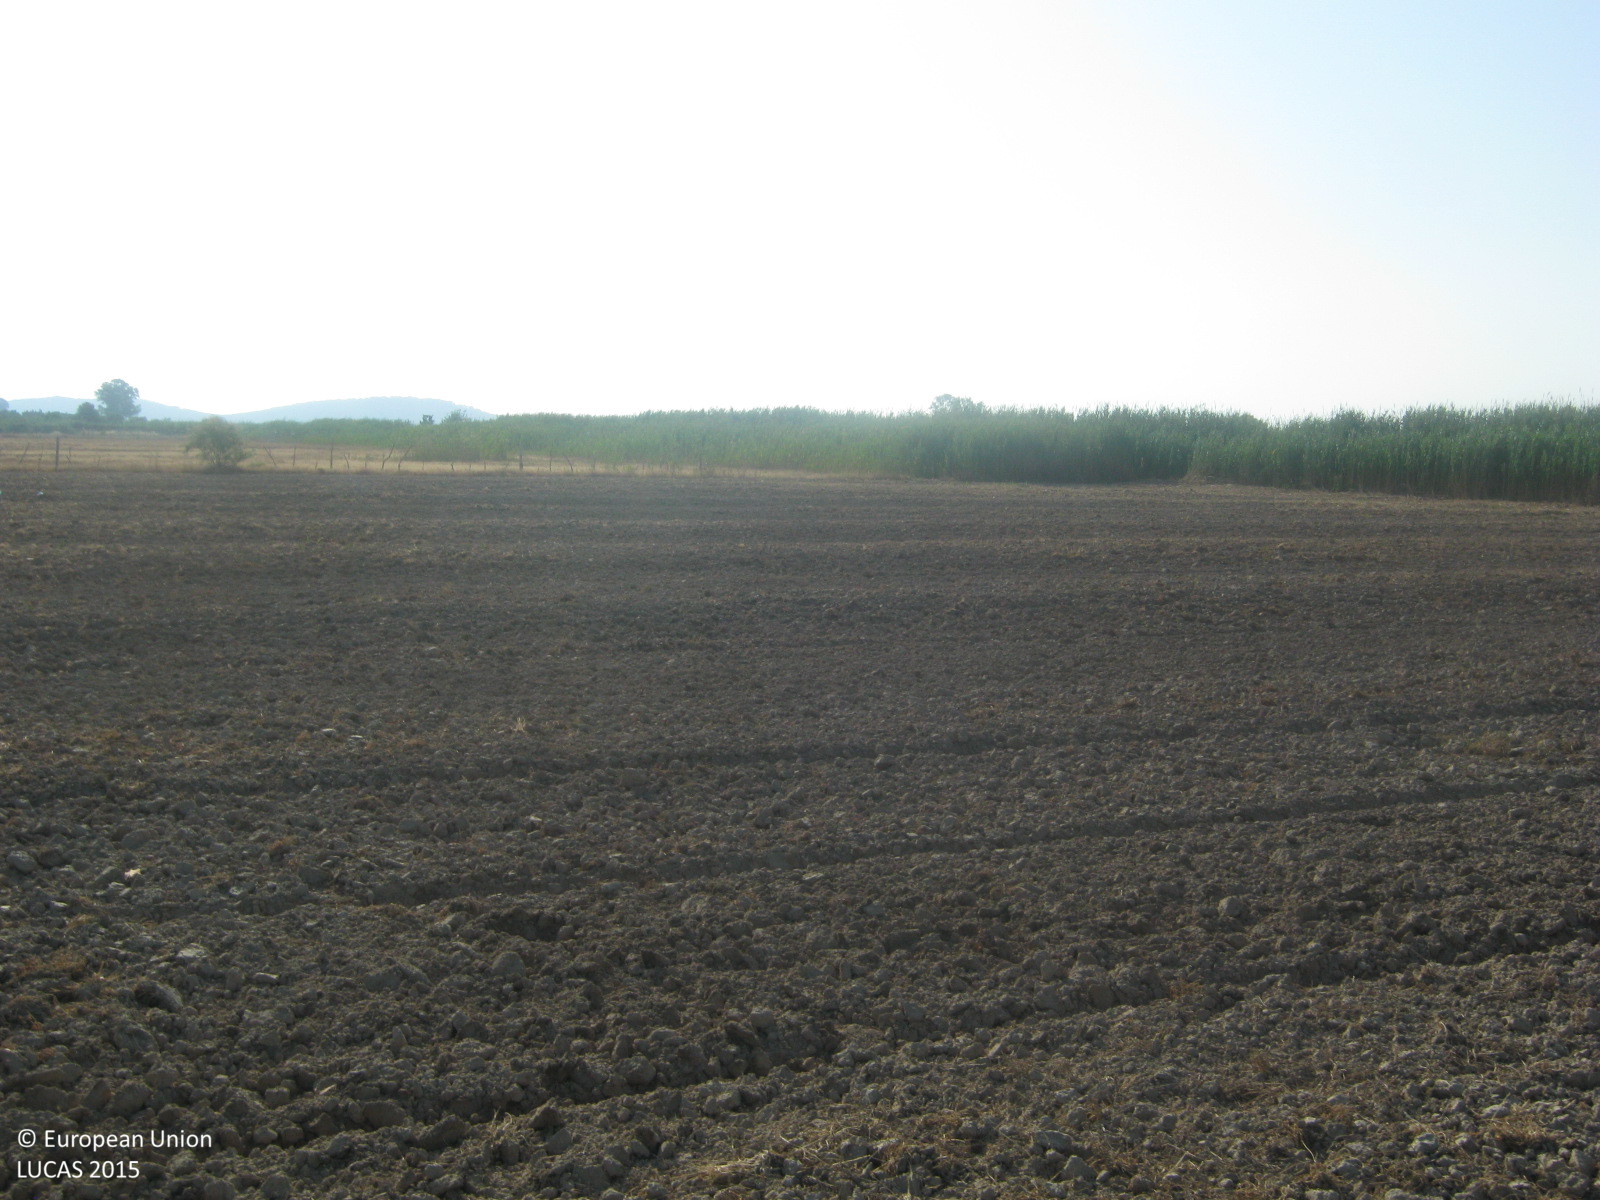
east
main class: Grassland
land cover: Spontaneously vegetated surfaces
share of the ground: 50 - 75 %
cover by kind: herbaceous plants 60 %, unconsolidated bare surface 35 %, shrubs 5 %
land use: Semi-natural and natural areas not in use
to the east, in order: Spontaneously vegetated surfaces; Fences; Spontaneously vegetated surfaces; Shruby margins; Ditches and canals; Shruby margins; Tracks; Shruby margins; Ditches and canals; Shruby margins
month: June
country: GR
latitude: 38.3897
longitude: 21.2896
